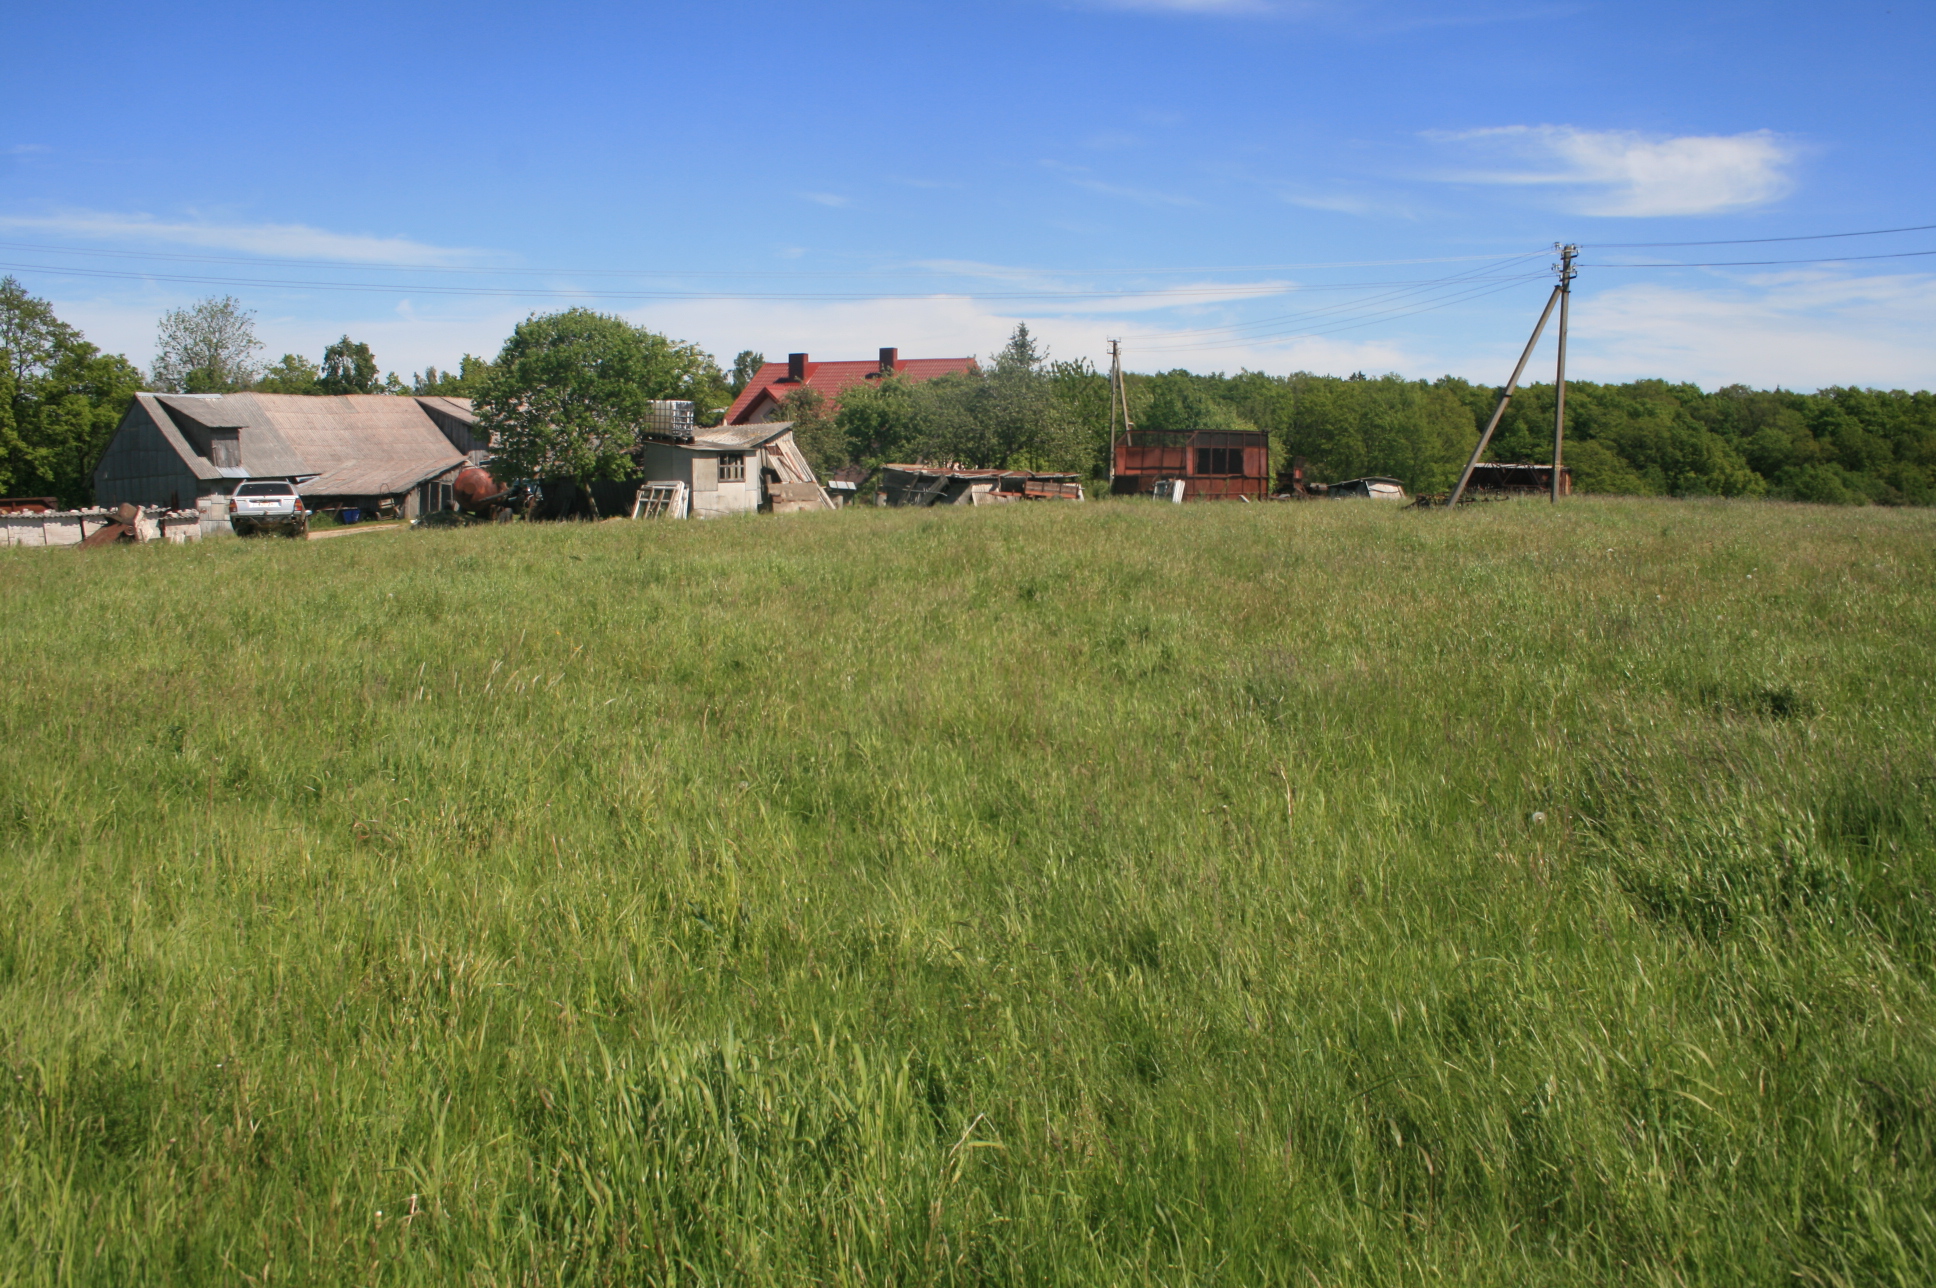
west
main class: Grassland
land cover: Grassland without tree/shrub cover
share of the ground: > 75 %
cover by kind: herbaceous plants 100 %
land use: Agriculture (excluding fallow land and kitchen gardens)
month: June
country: LT
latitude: 55.9125
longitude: 21.4183
